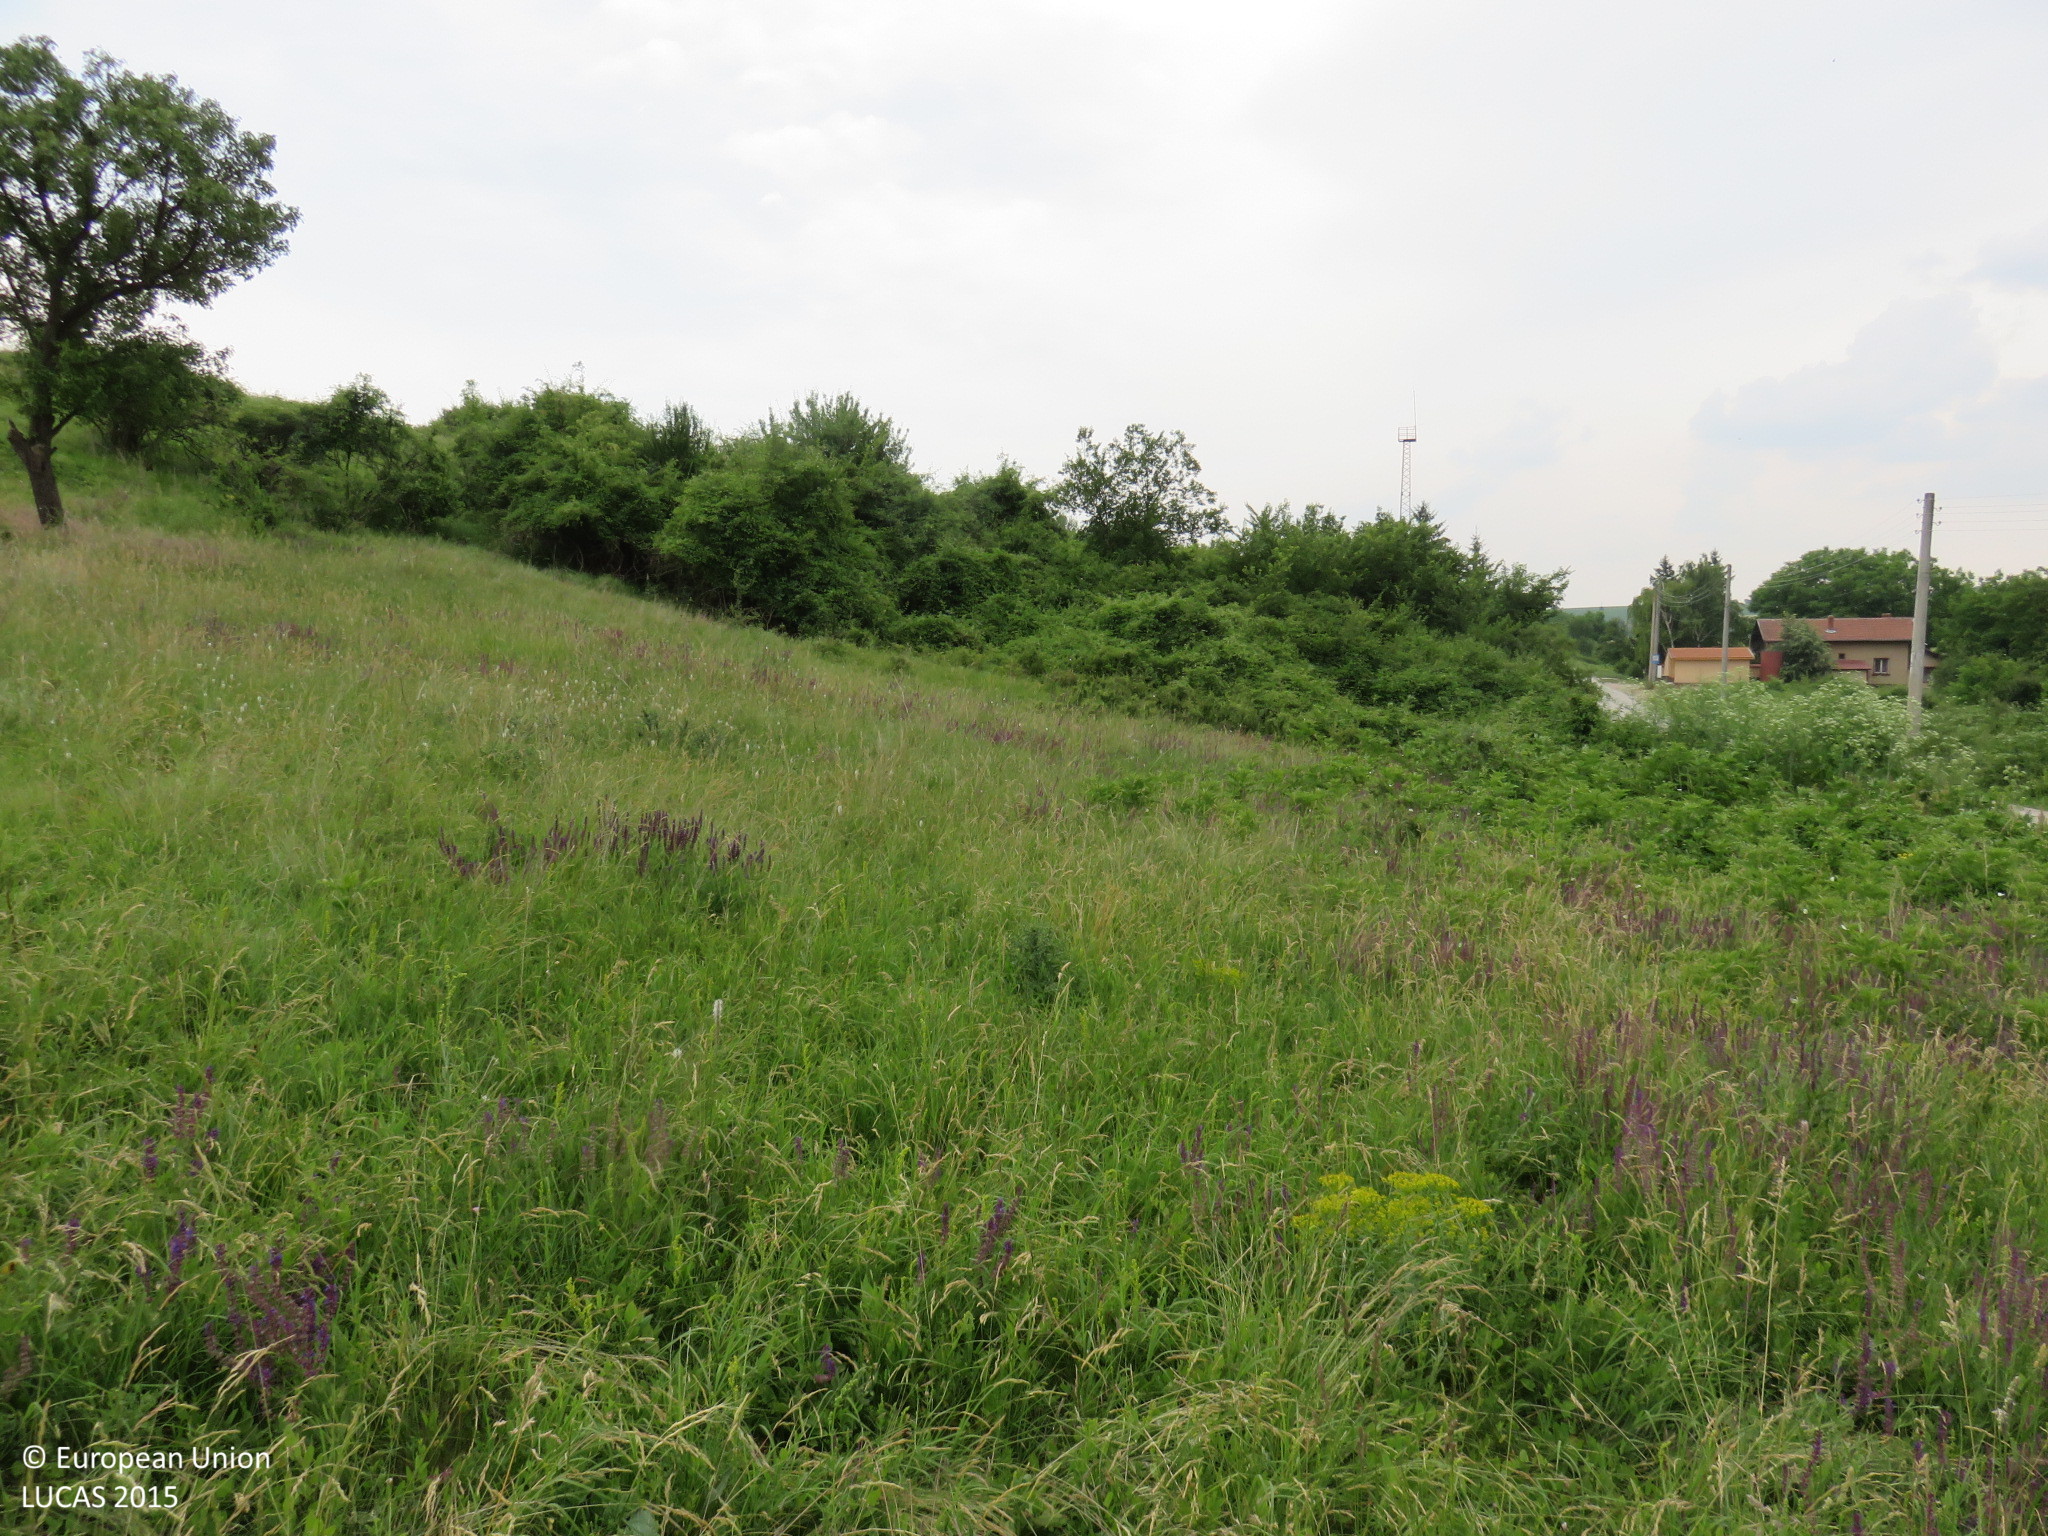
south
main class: Grassland
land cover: Grassland without tree/shrub cover
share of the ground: > 75 %
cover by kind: herbaceous plants 100 %
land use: Semi-natural and natural areas not in use
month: June
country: BG
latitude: 43.3468
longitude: 24.4809
